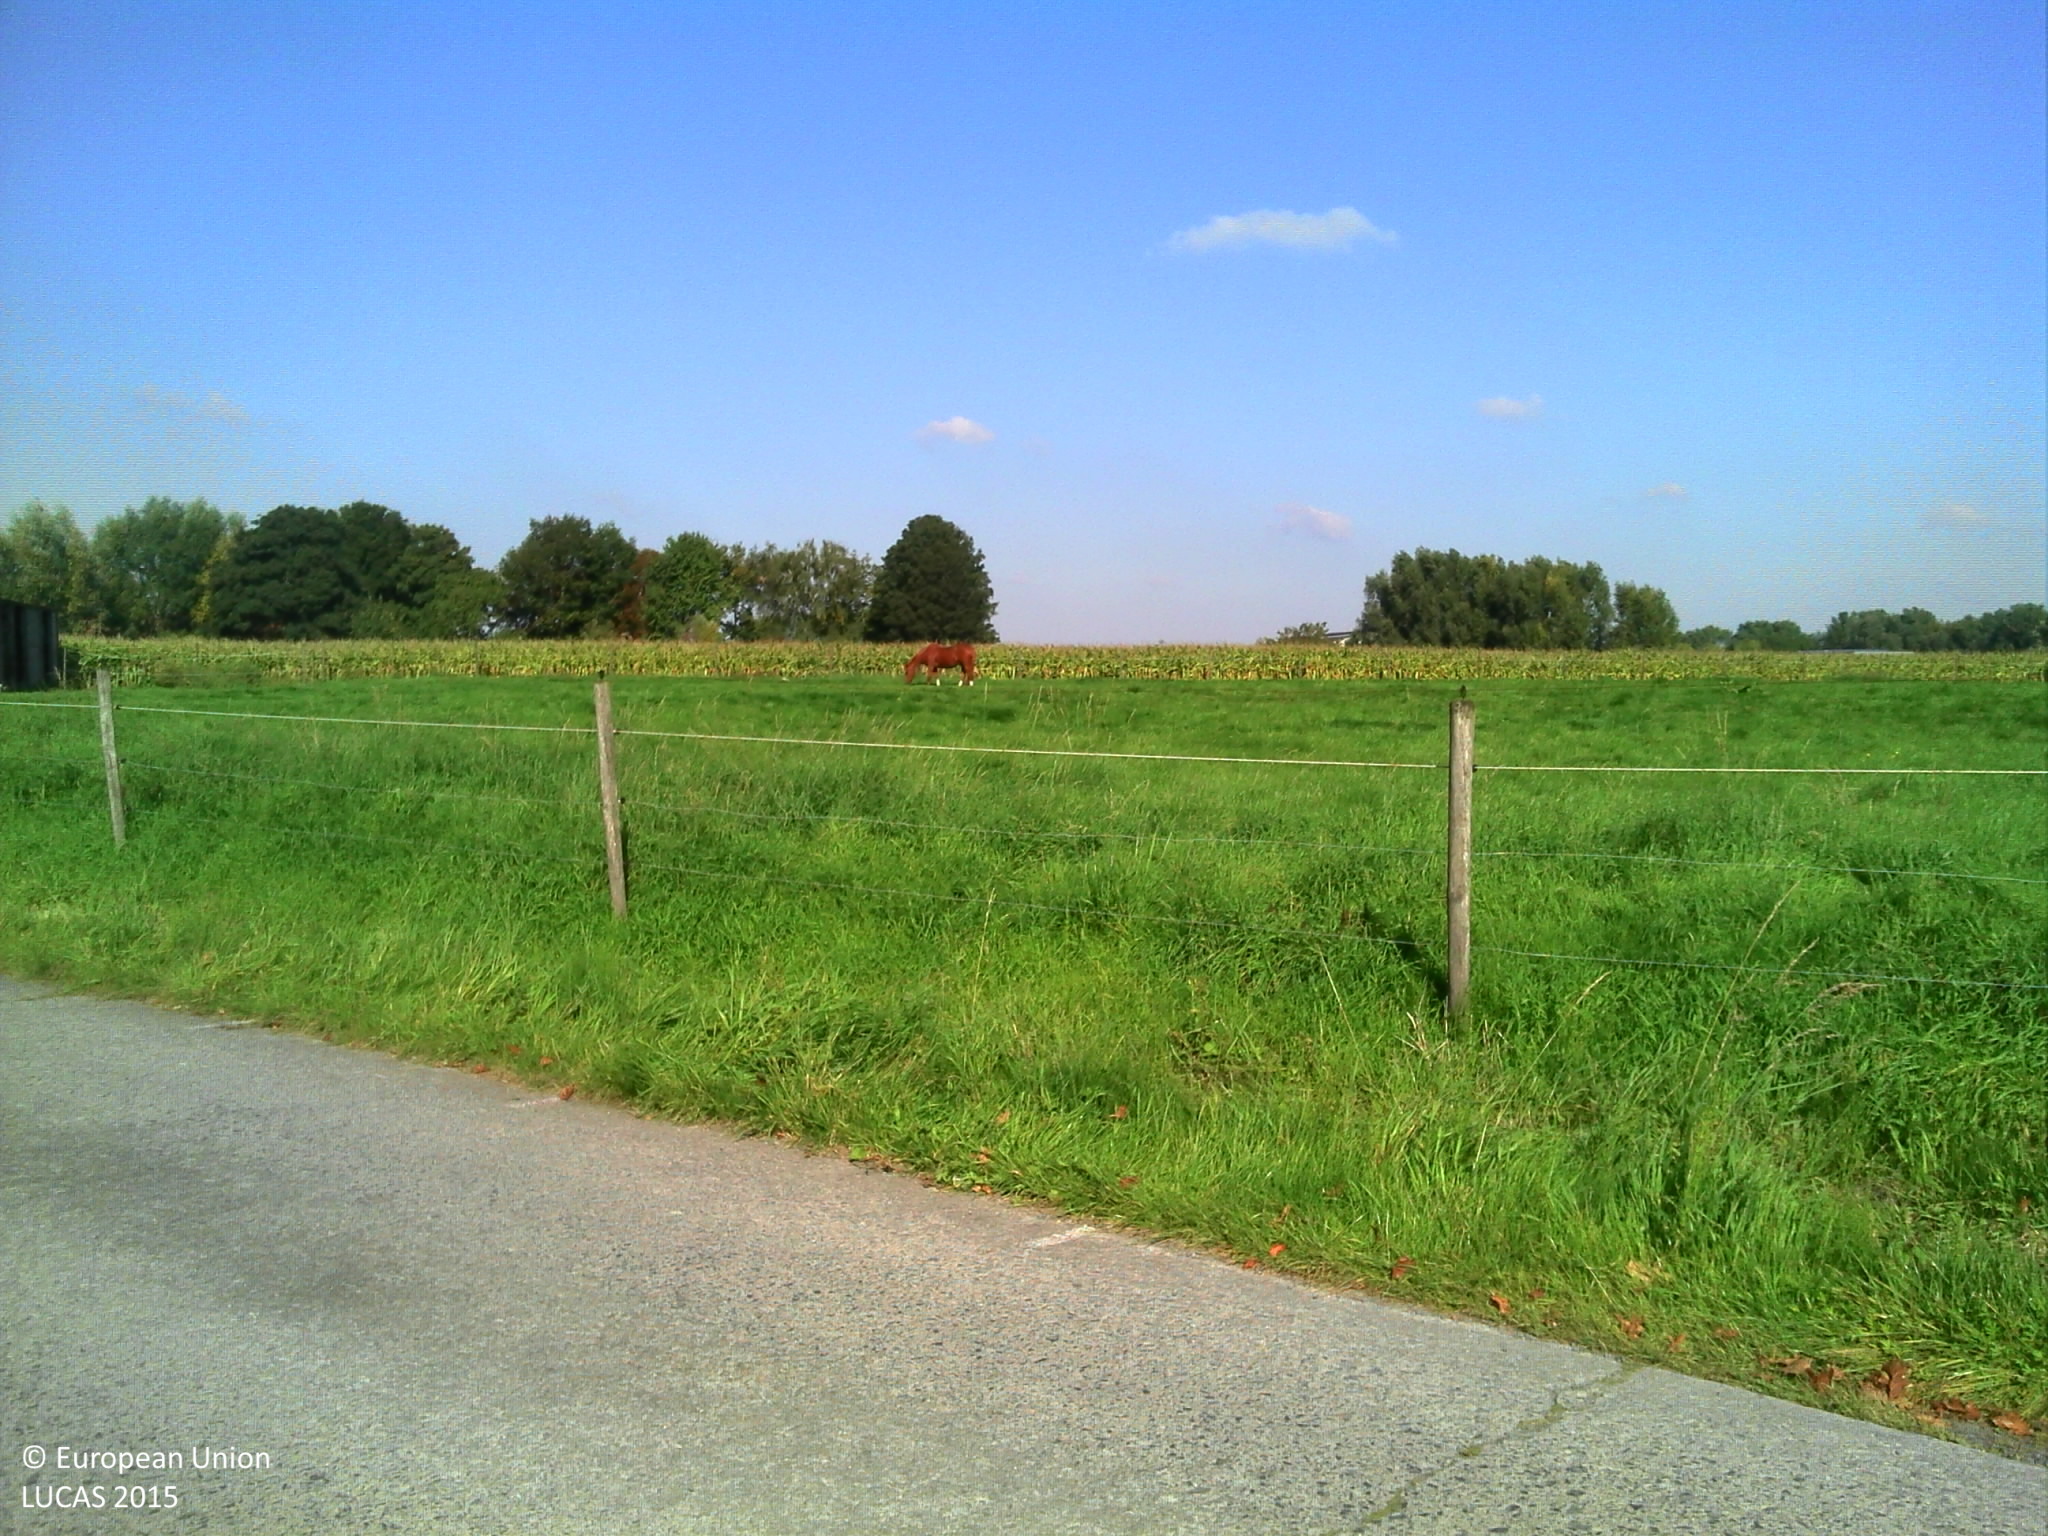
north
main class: Grassland
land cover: Grassland without tree/shrub cover
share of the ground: > 75 %
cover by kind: herbaceous plants 80 %, unconsolidated bare surface 20 %
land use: Residential
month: October
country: BE
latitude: 51.0187
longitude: 3.0477
